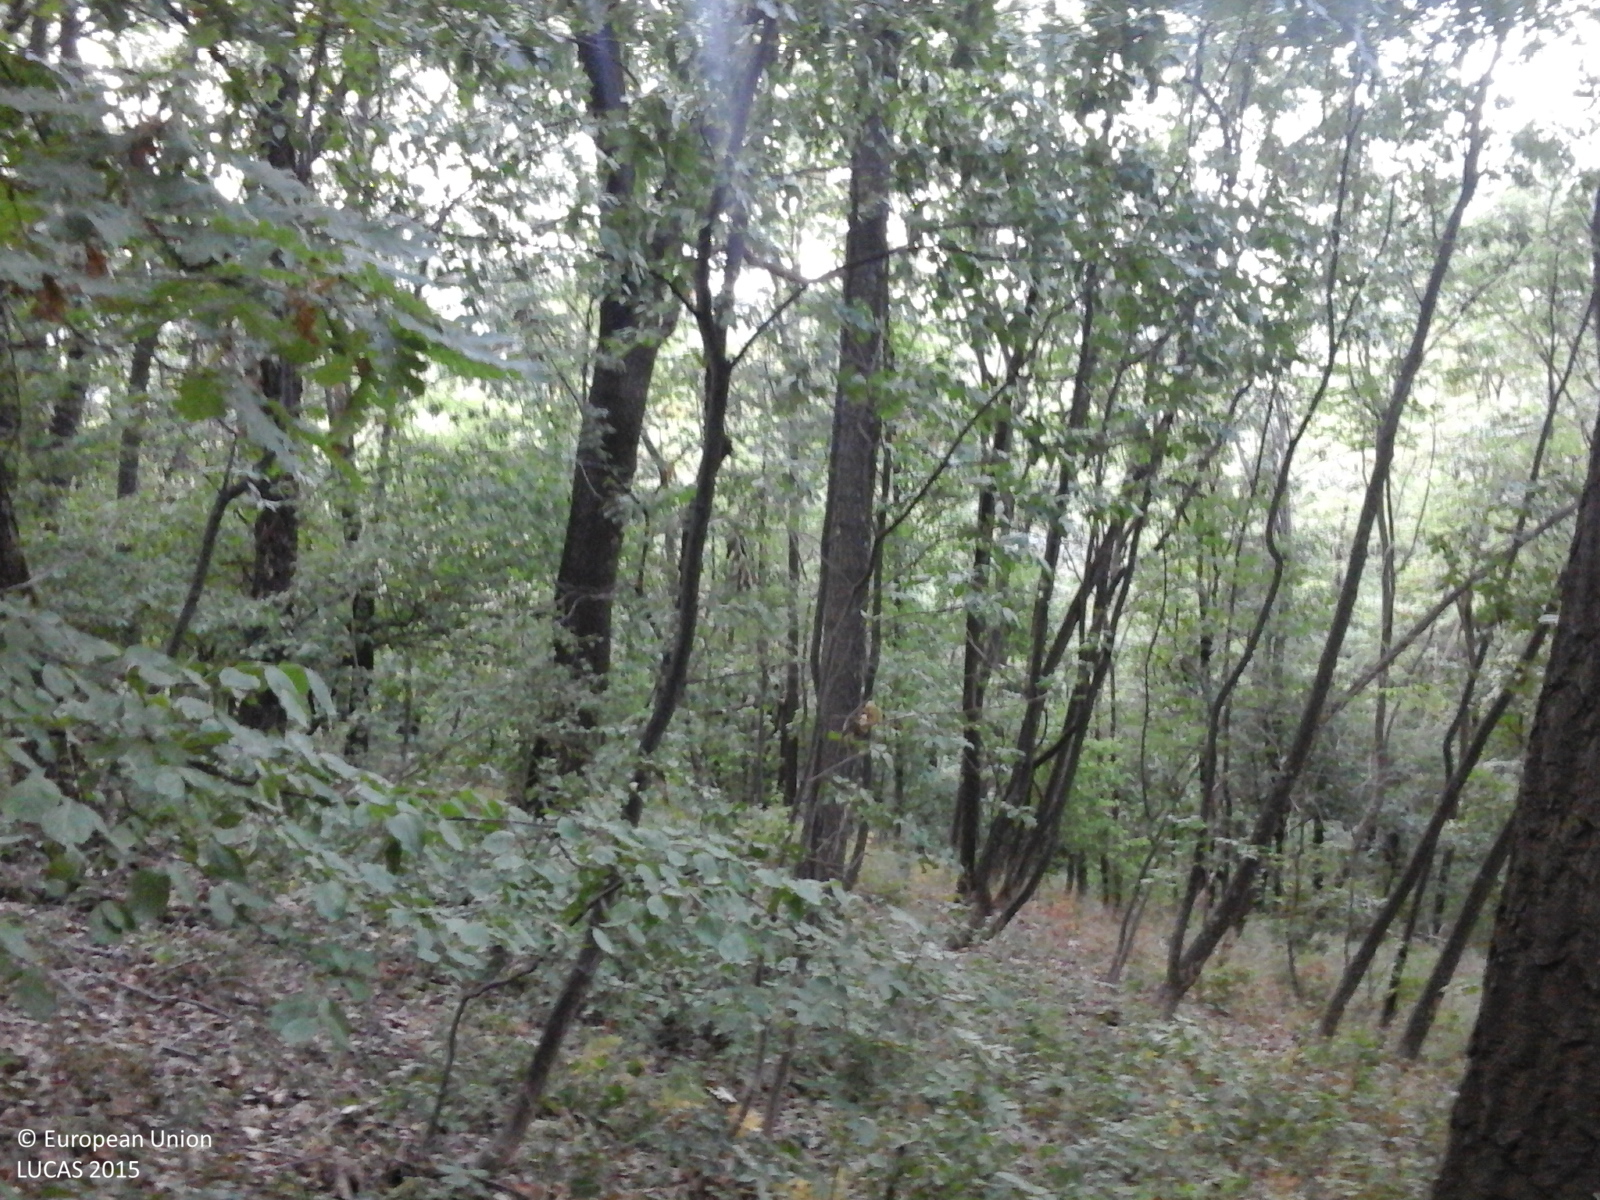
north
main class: Woodland
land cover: Broadleaved woodland
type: acidophilous oak and oak-birch forest
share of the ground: > 75 %
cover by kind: broadleaved forest trees 100 %
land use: Forestry
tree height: > 5 m
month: August
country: RO
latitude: 44.5643
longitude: 23.1810
